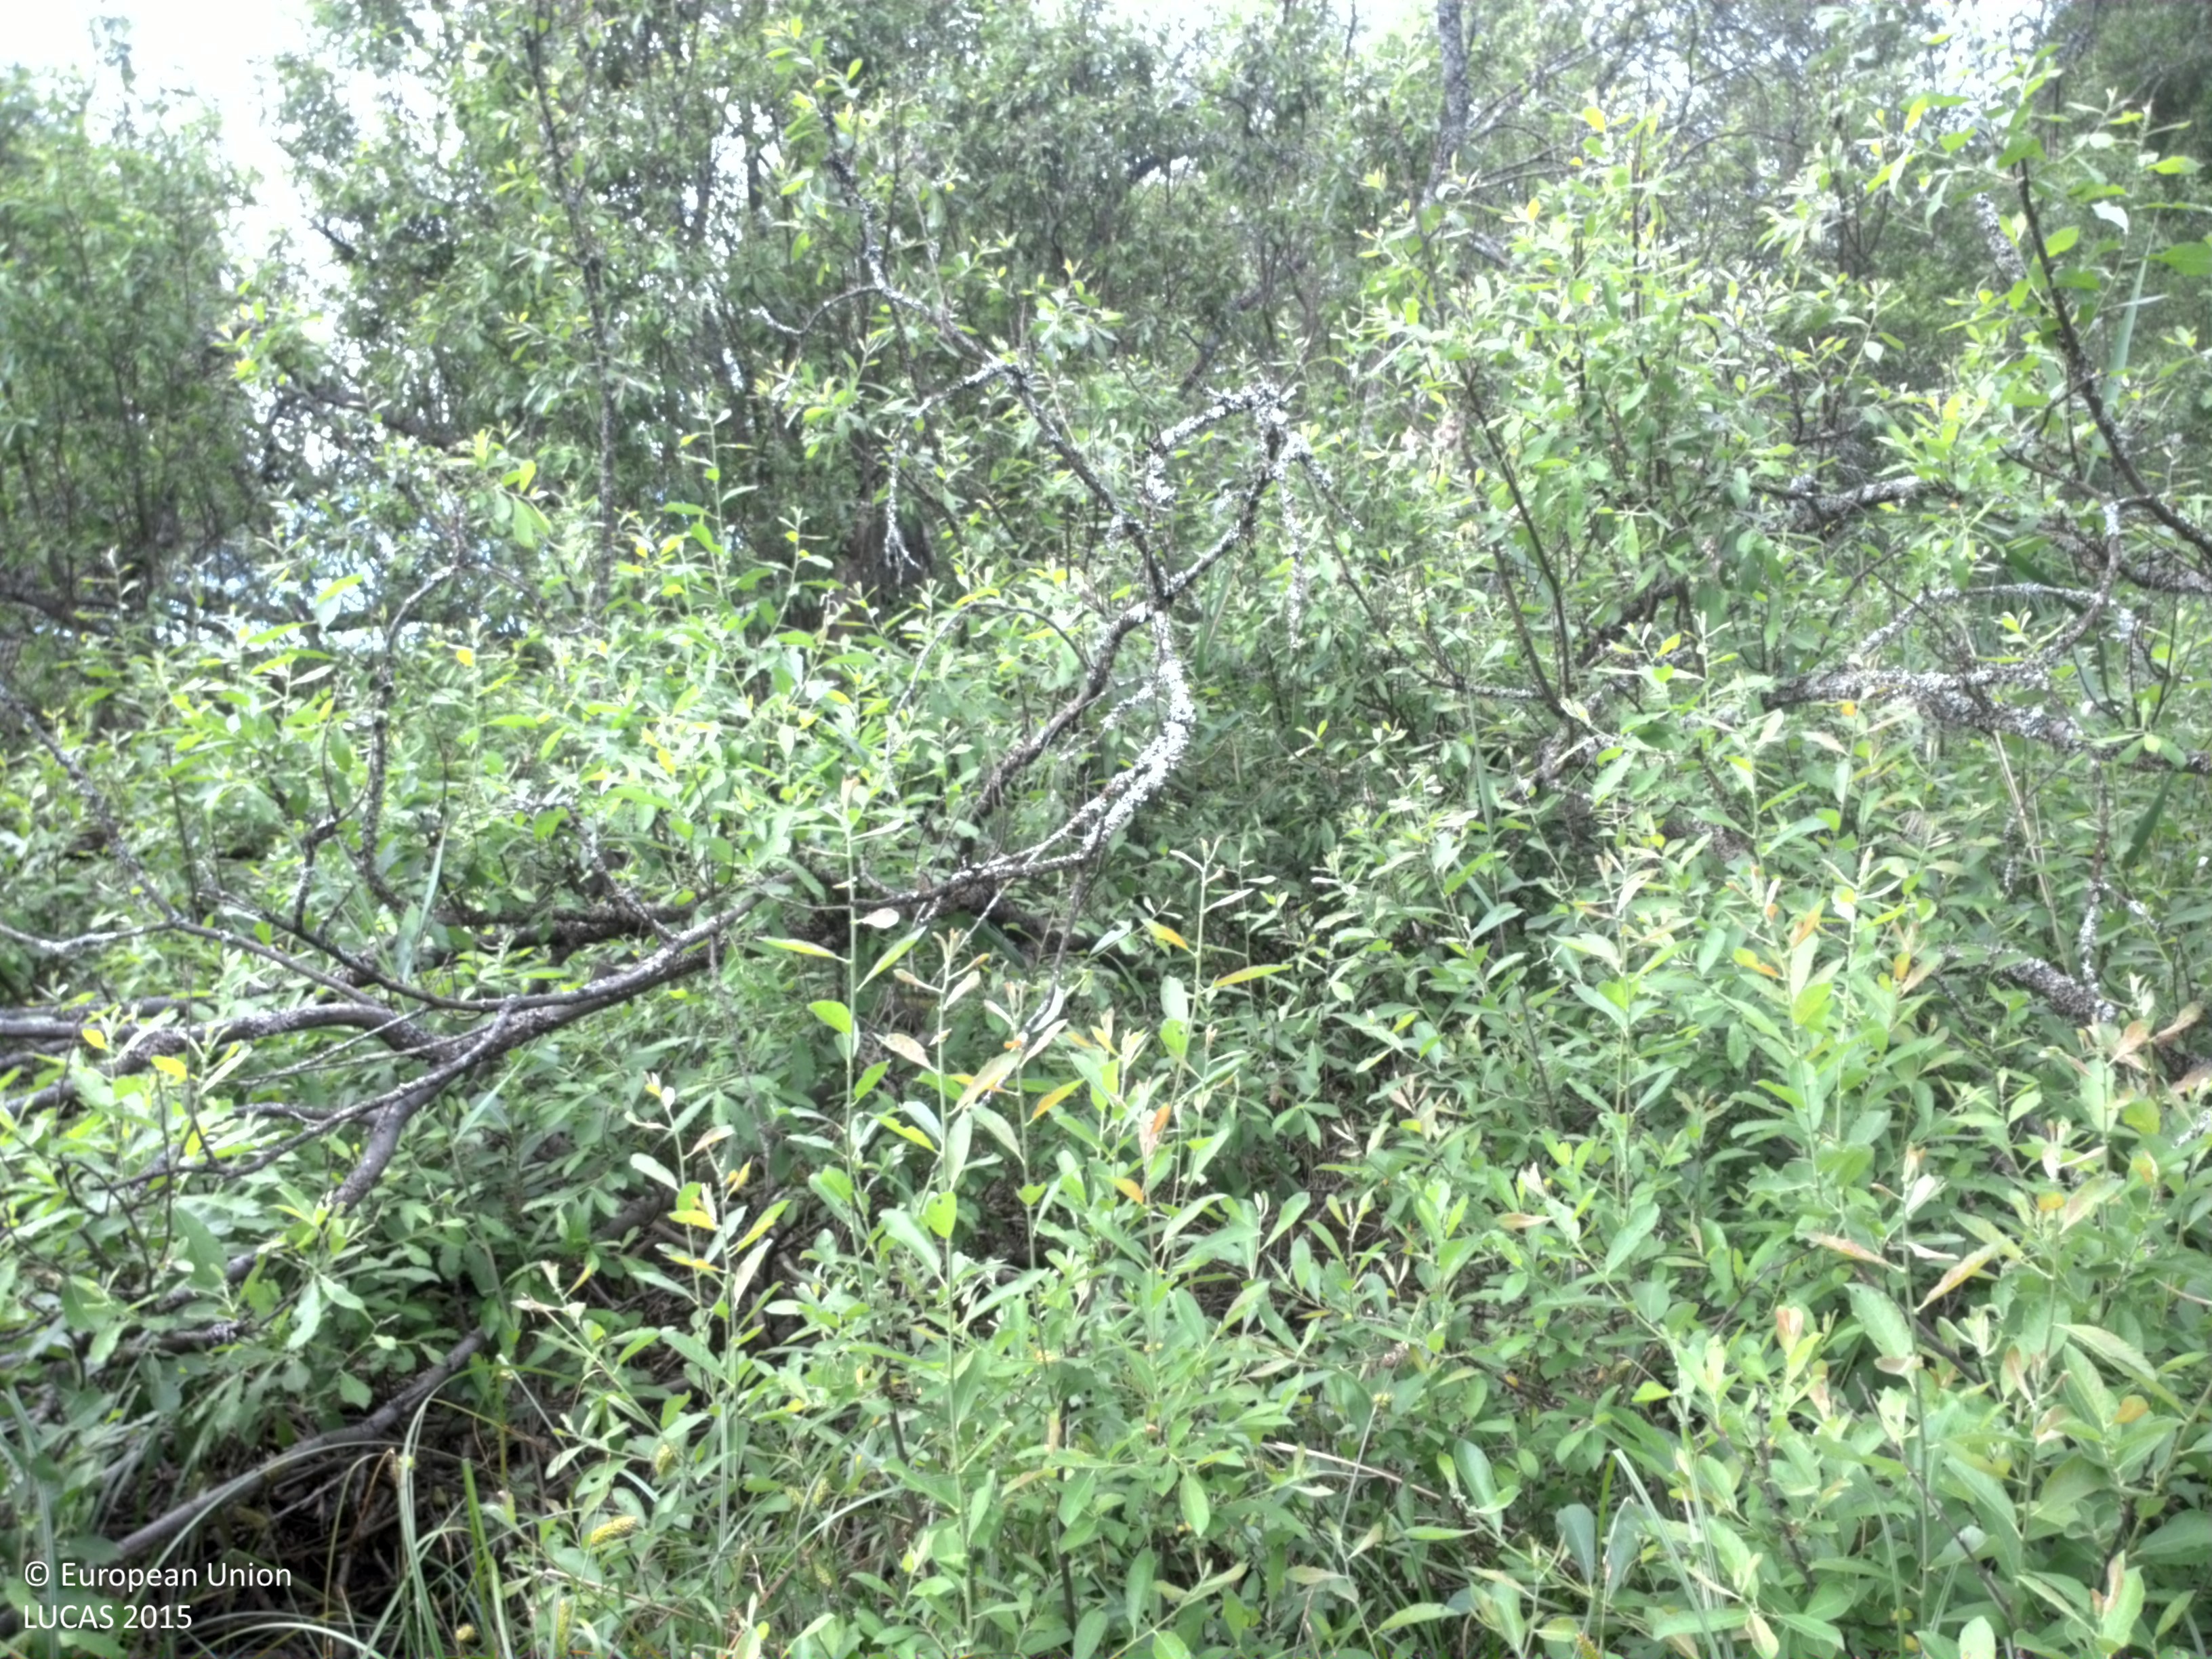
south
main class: Shrubland
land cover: Shrubland with sparse tree cover
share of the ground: 50 - 75 %
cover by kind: shrubs 55 %, herbaceous plants 40 %, broadleaved forest trees 5 %
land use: Semi-natural and natural areas not in use
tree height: < 5 m
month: July
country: SE
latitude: 59.8062
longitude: 12.0087
